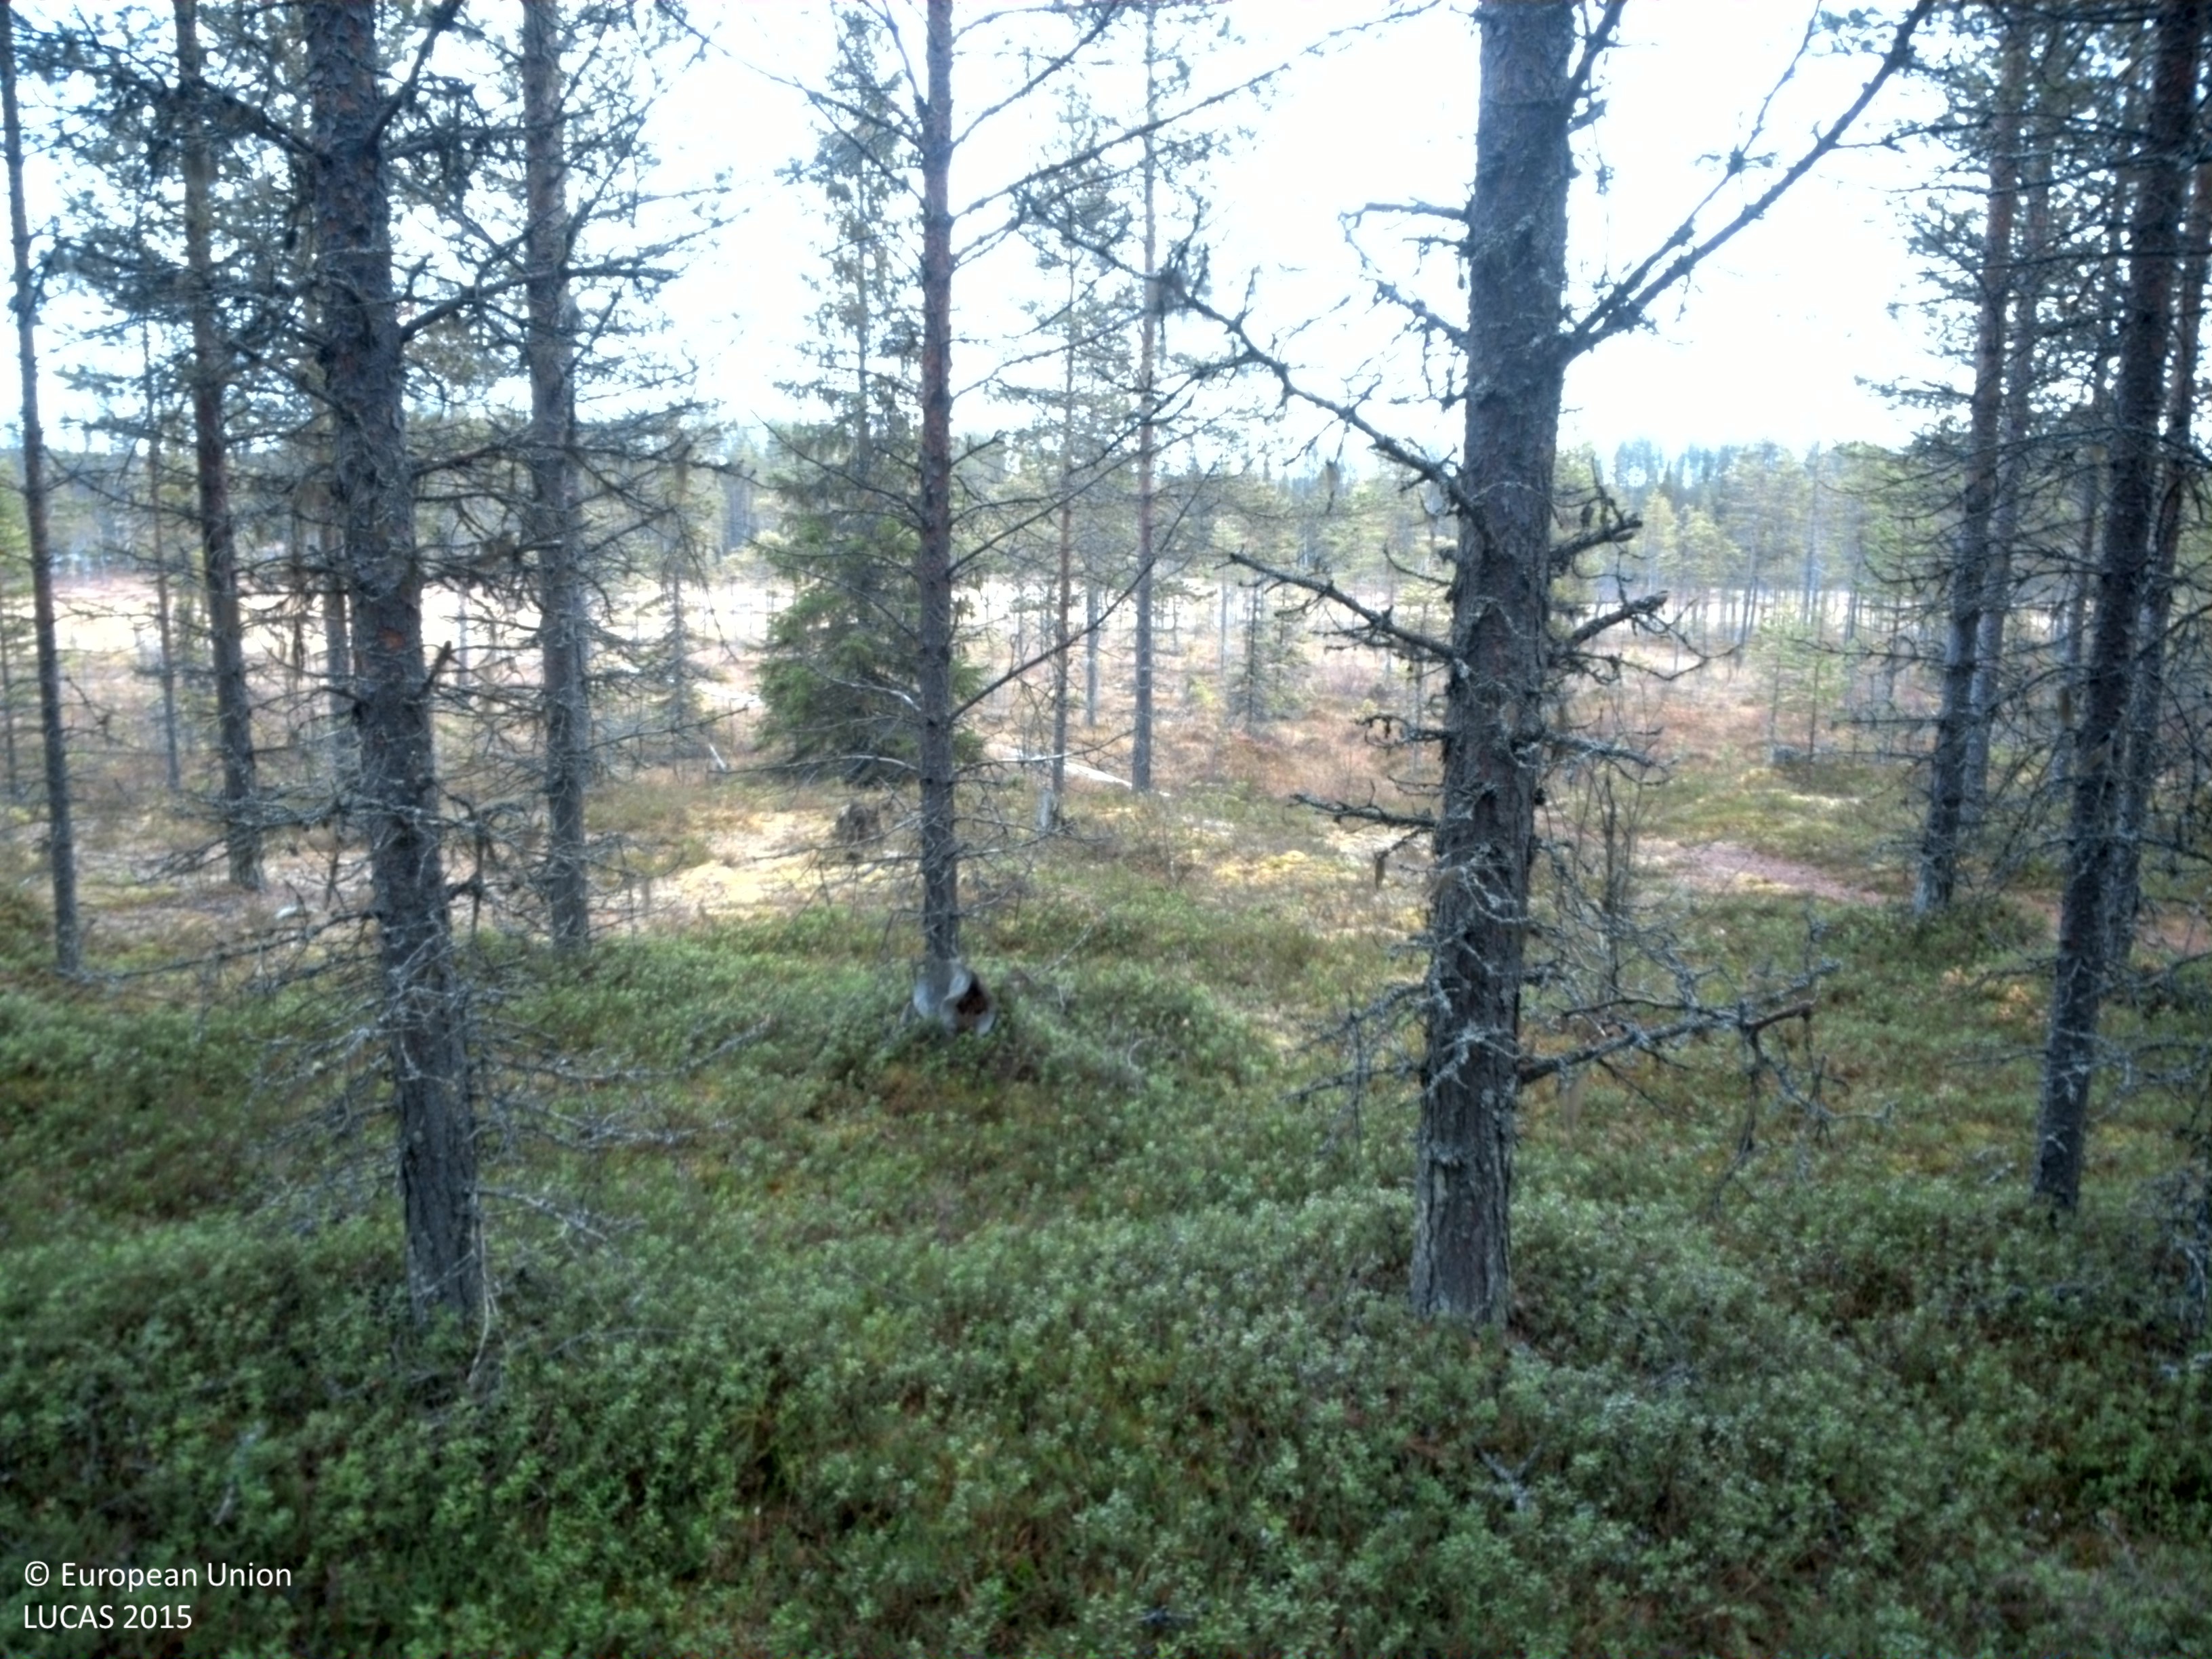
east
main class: Woodland
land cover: Pine dominated coniferous woodland
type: boreal forest
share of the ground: 25 - 50 %
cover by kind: coniferous forest trees 40 %, shrubs 40 %, lichens and mosses 20 %
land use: Forestry
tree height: > 5 m
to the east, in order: Pine dominated coniferous woodland; Tracks; Other coniferous woodland; Pine dominated coniferous woodland; Shrubland without tree cover; Peatbogs; Shrubland without tree cover; Grassland without tree/shrub cover
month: October
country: SE
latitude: 64.6670
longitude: 16.8577
